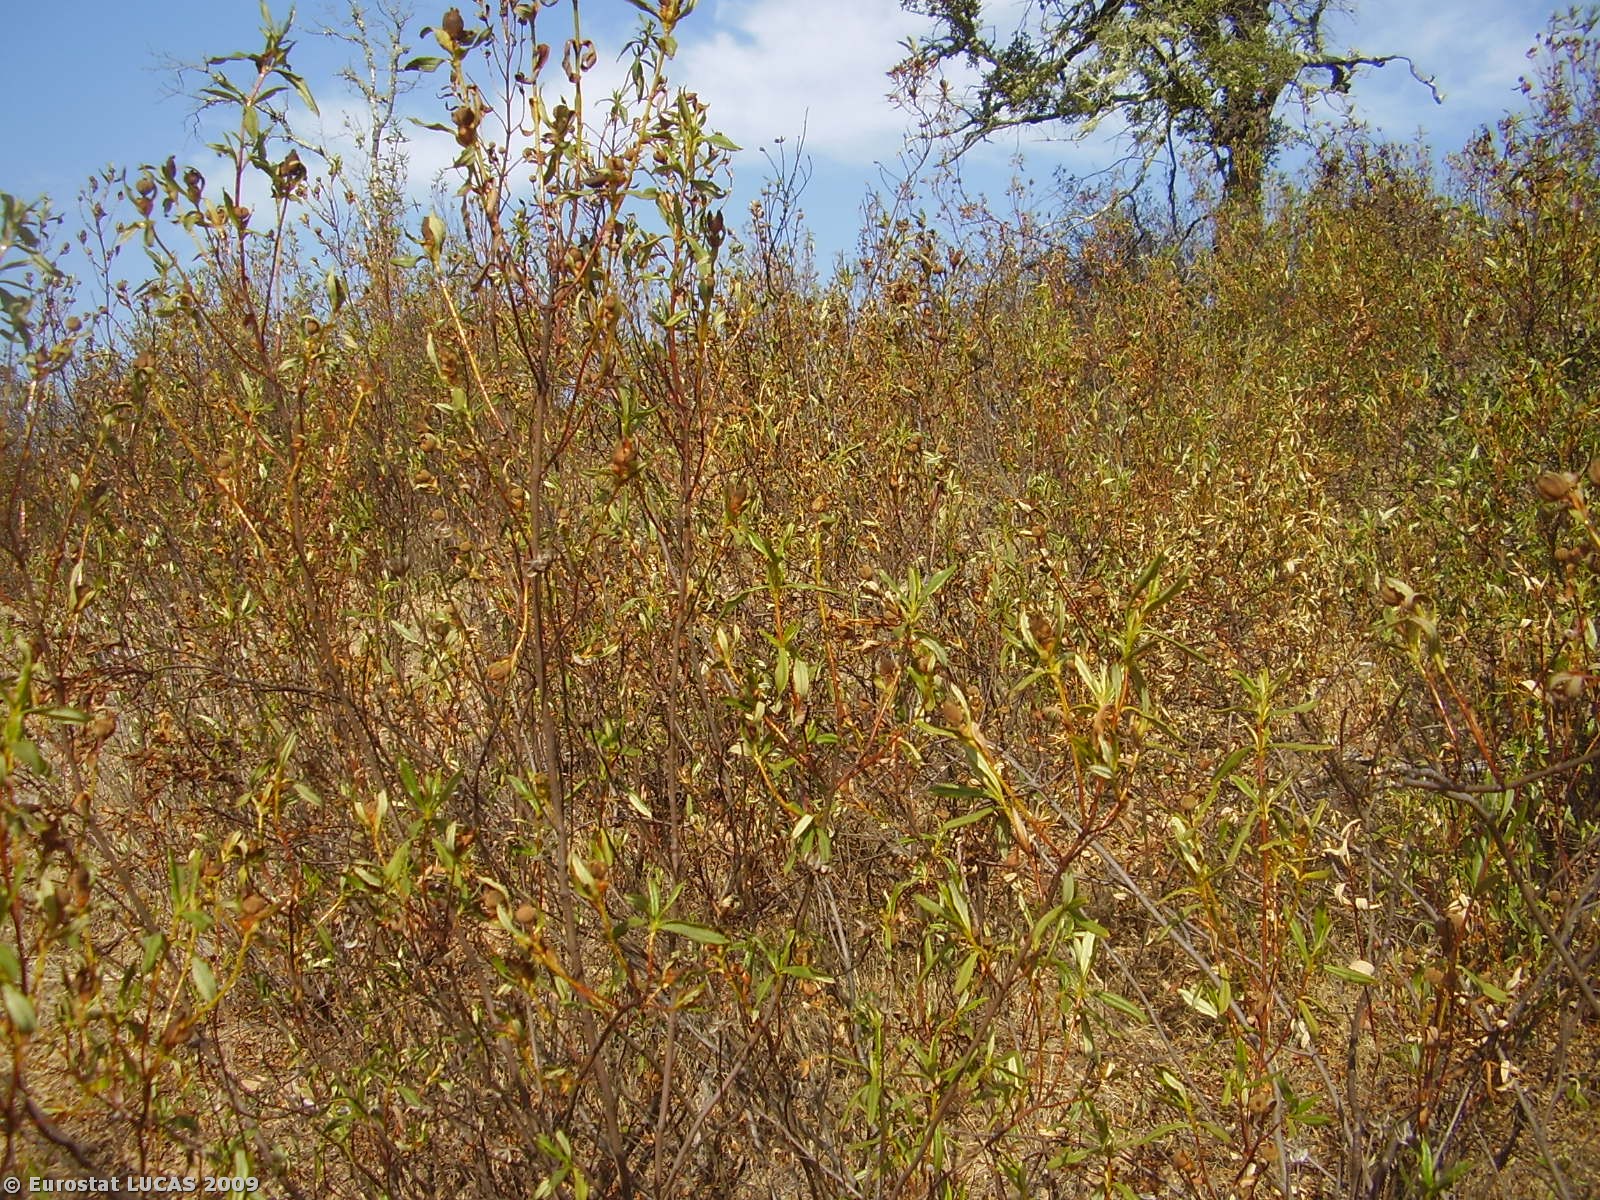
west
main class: Shrubland
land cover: Shrubland with sparse tree cover
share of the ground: 50 - 75 %
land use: Forestry
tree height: > 5 m
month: August
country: PT
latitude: 37.5598
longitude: -8.2422
